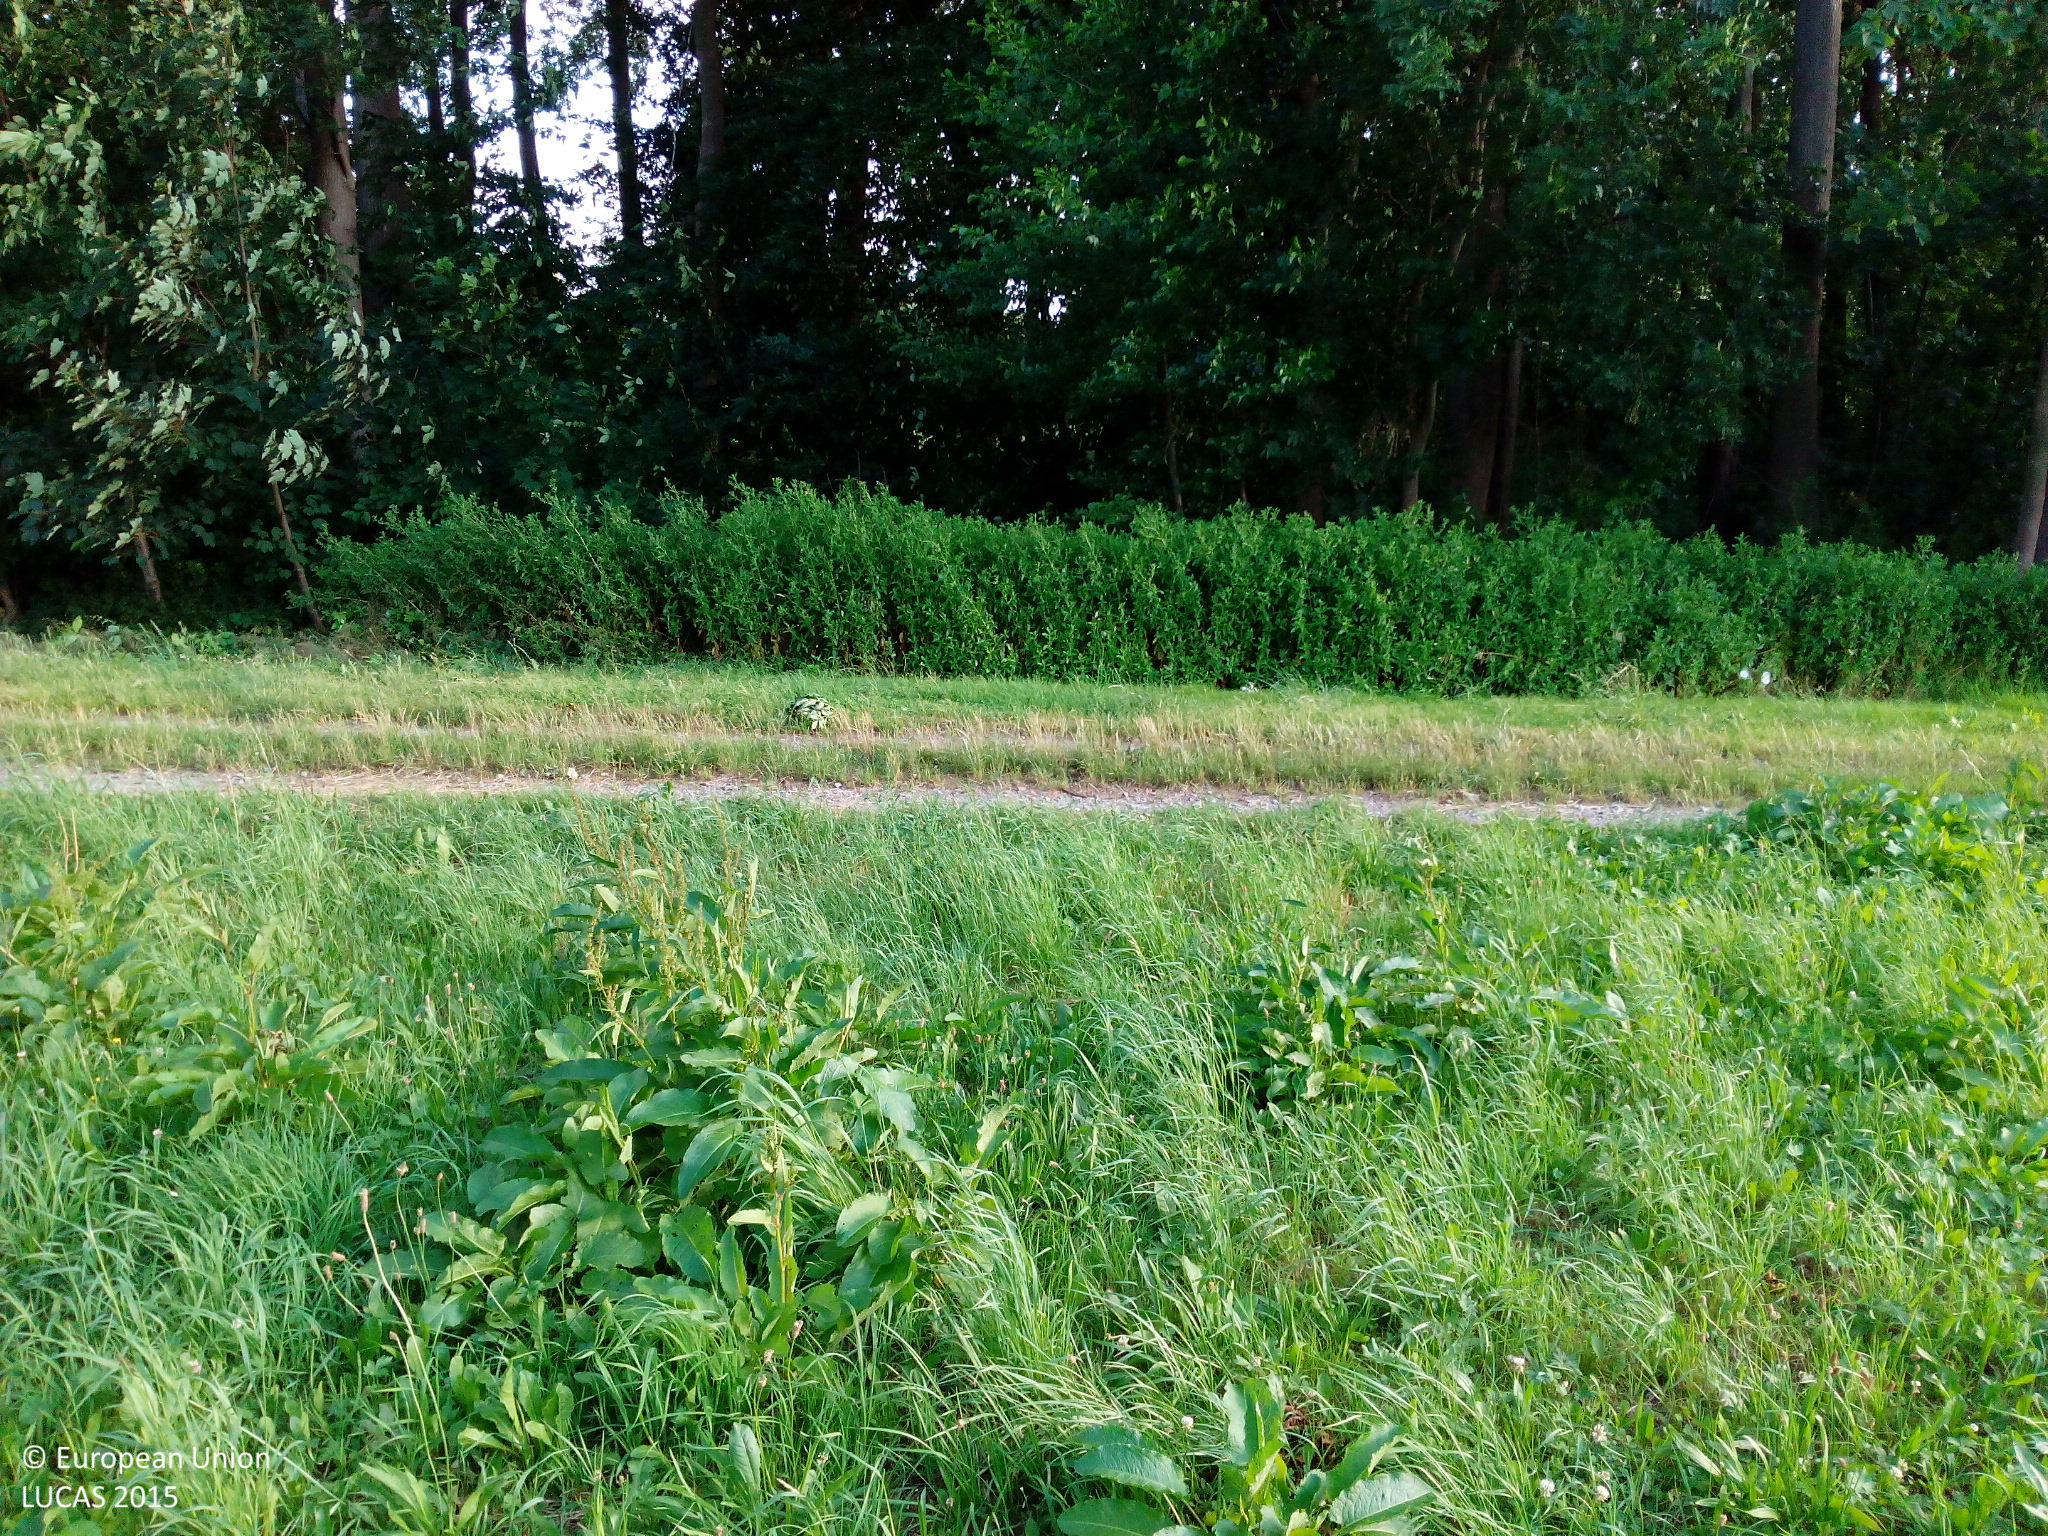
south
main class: Grassland
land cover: Grassland without tree/shrub cover
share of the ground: > 75 %
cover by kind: herbaceous plants 100 %
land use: Agriculture (excluding fallow land and kitchen gardens)
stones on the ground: < 10 %
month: July
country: DE
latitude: 49.6987
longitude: 9.9307
